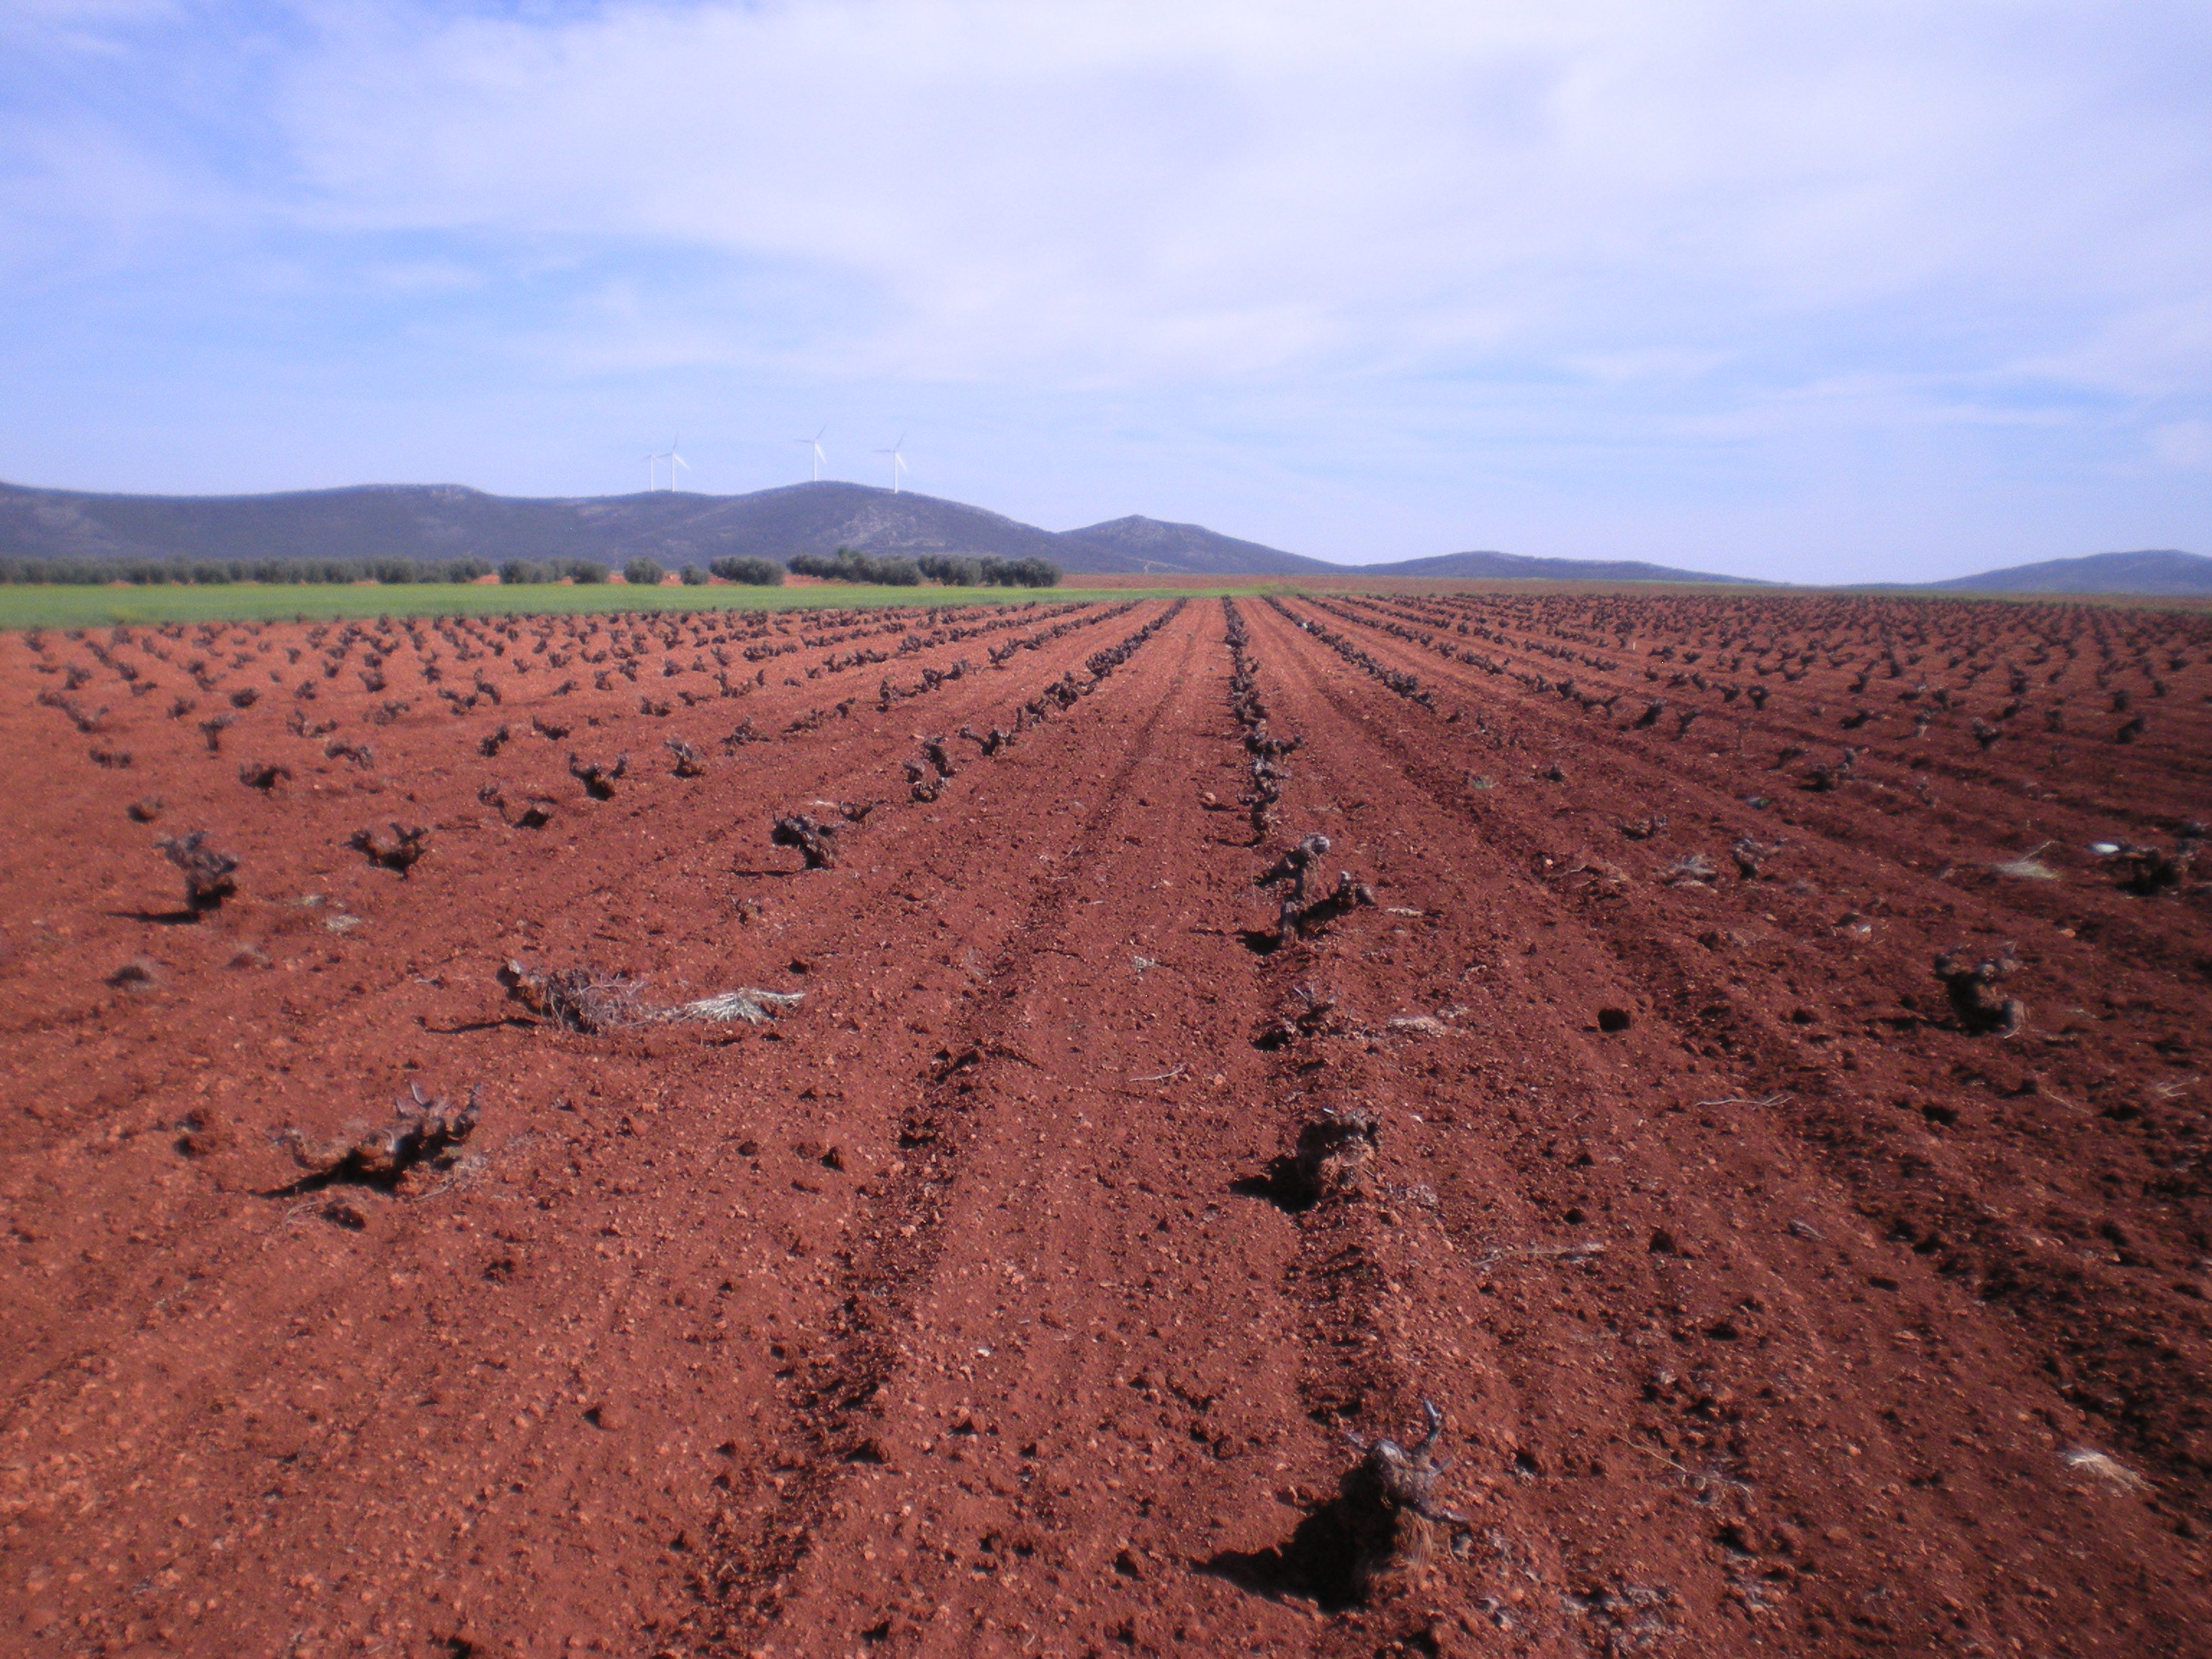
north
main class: Cropland
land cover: Vineyards
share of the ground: < 10 %
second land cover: Other bare soil
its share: > 75 %
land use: Agriculture (excluding fallow land and kitchen gardens)
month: April
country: ES
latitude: 38.8073
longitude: -3.1716
